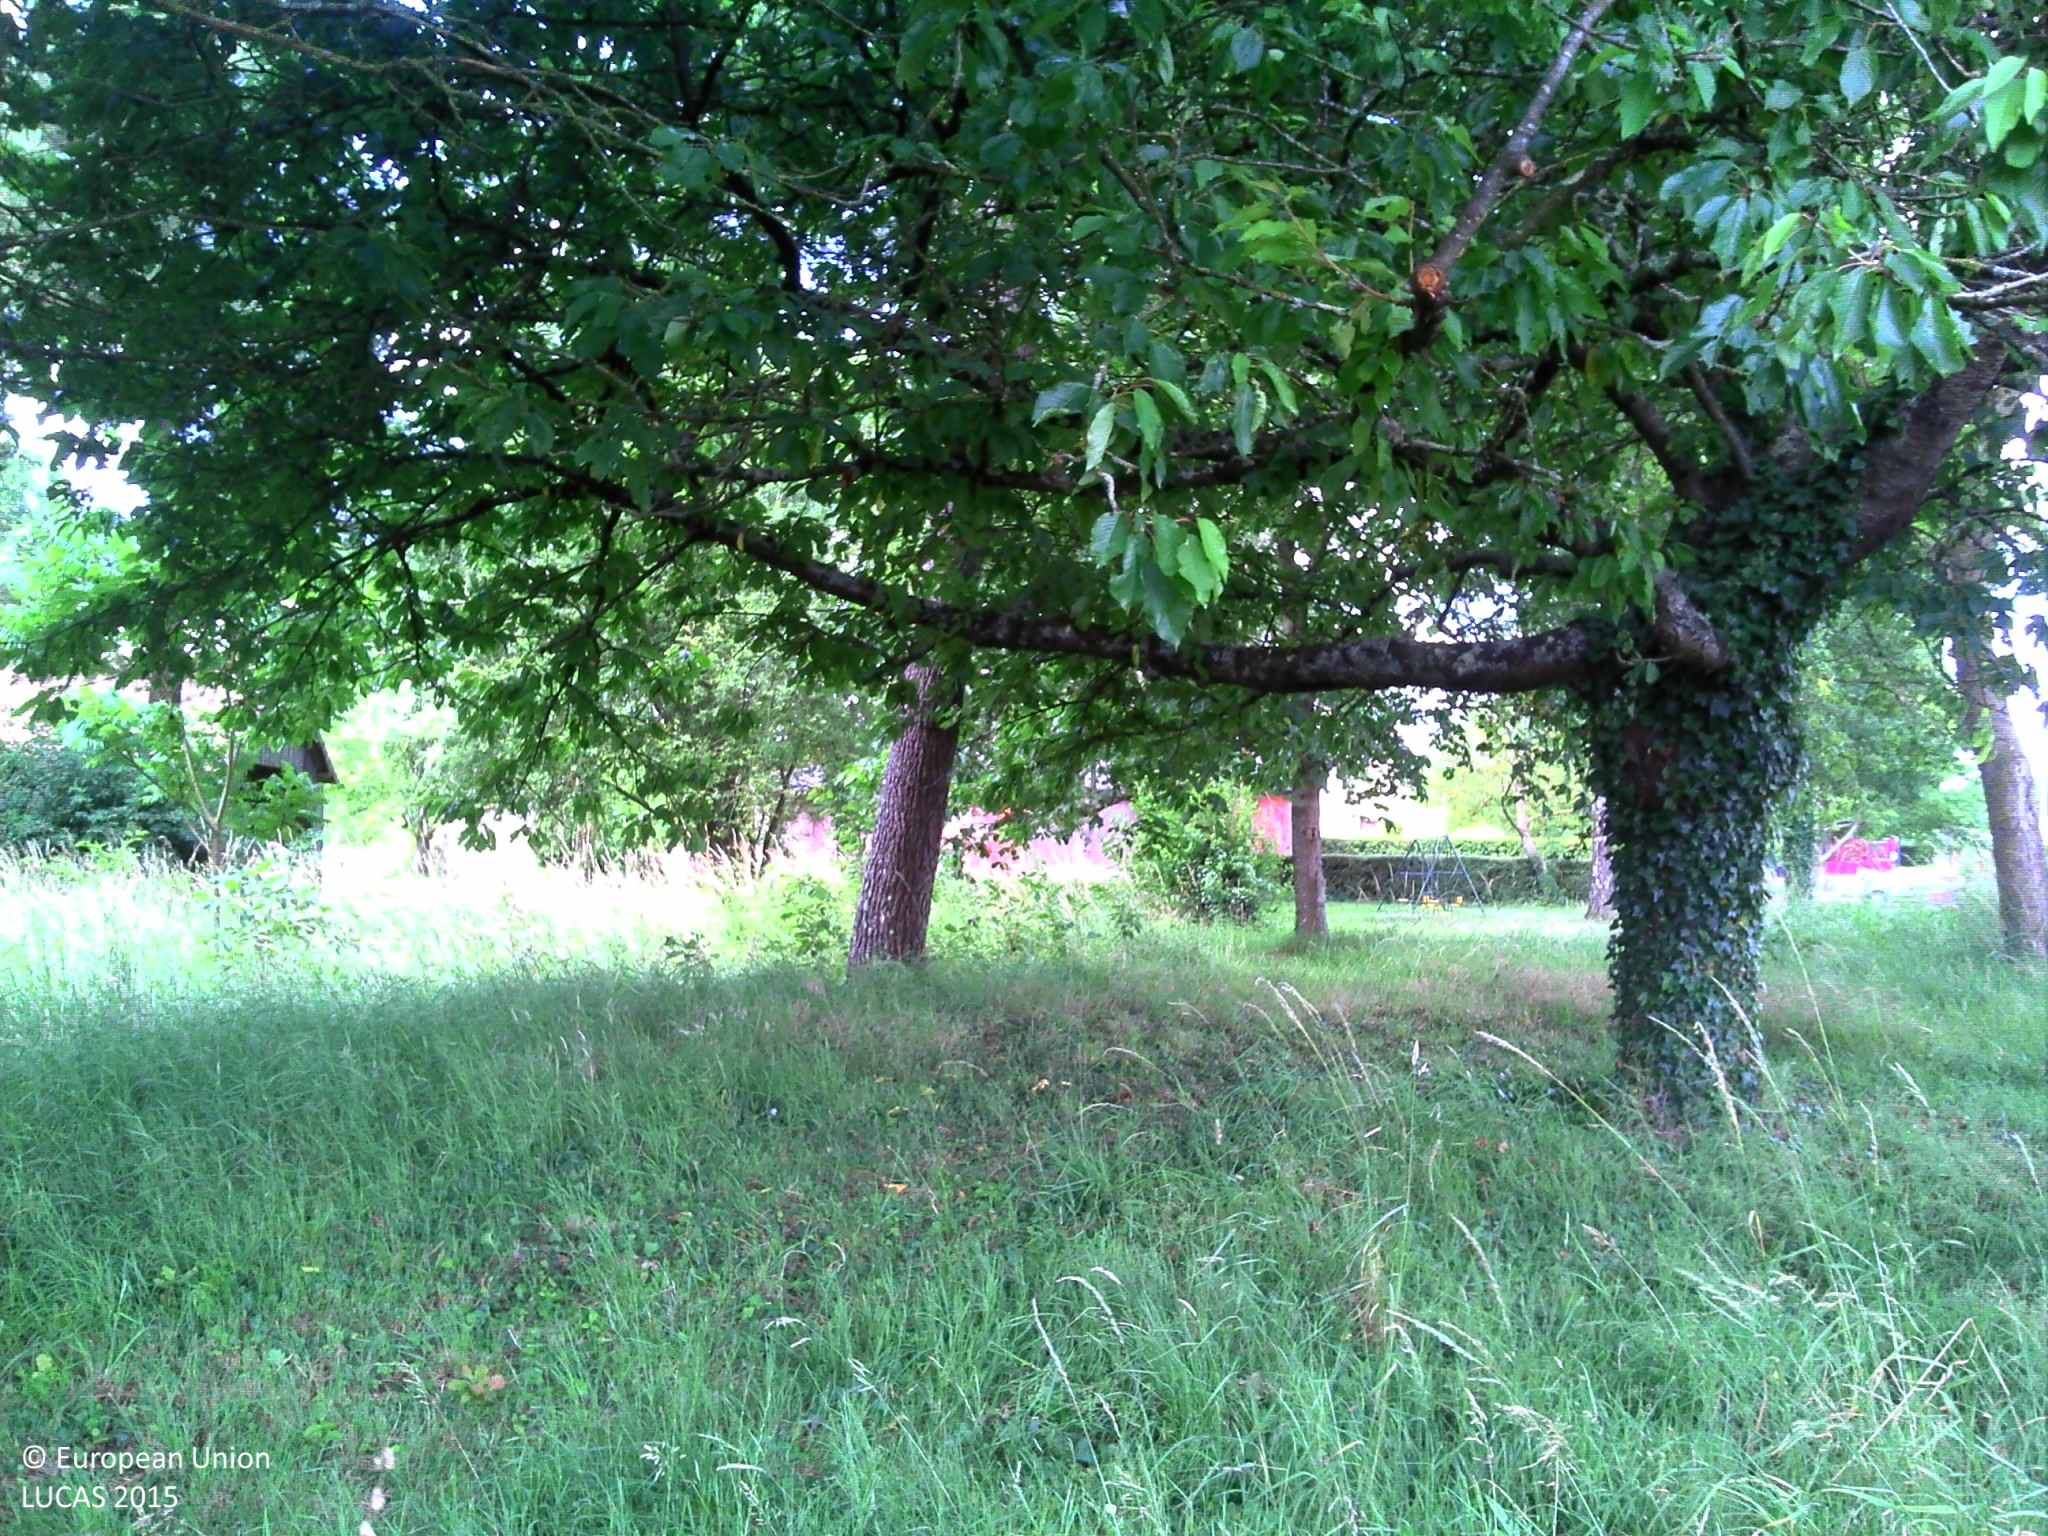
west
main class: Cropland
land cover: Rape and turnip rape
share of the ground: > 75 %
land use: Agriculture (excluding fallow land and kitchen gardens)
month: June
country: FR
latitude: 47.8813
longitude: 0.2534
